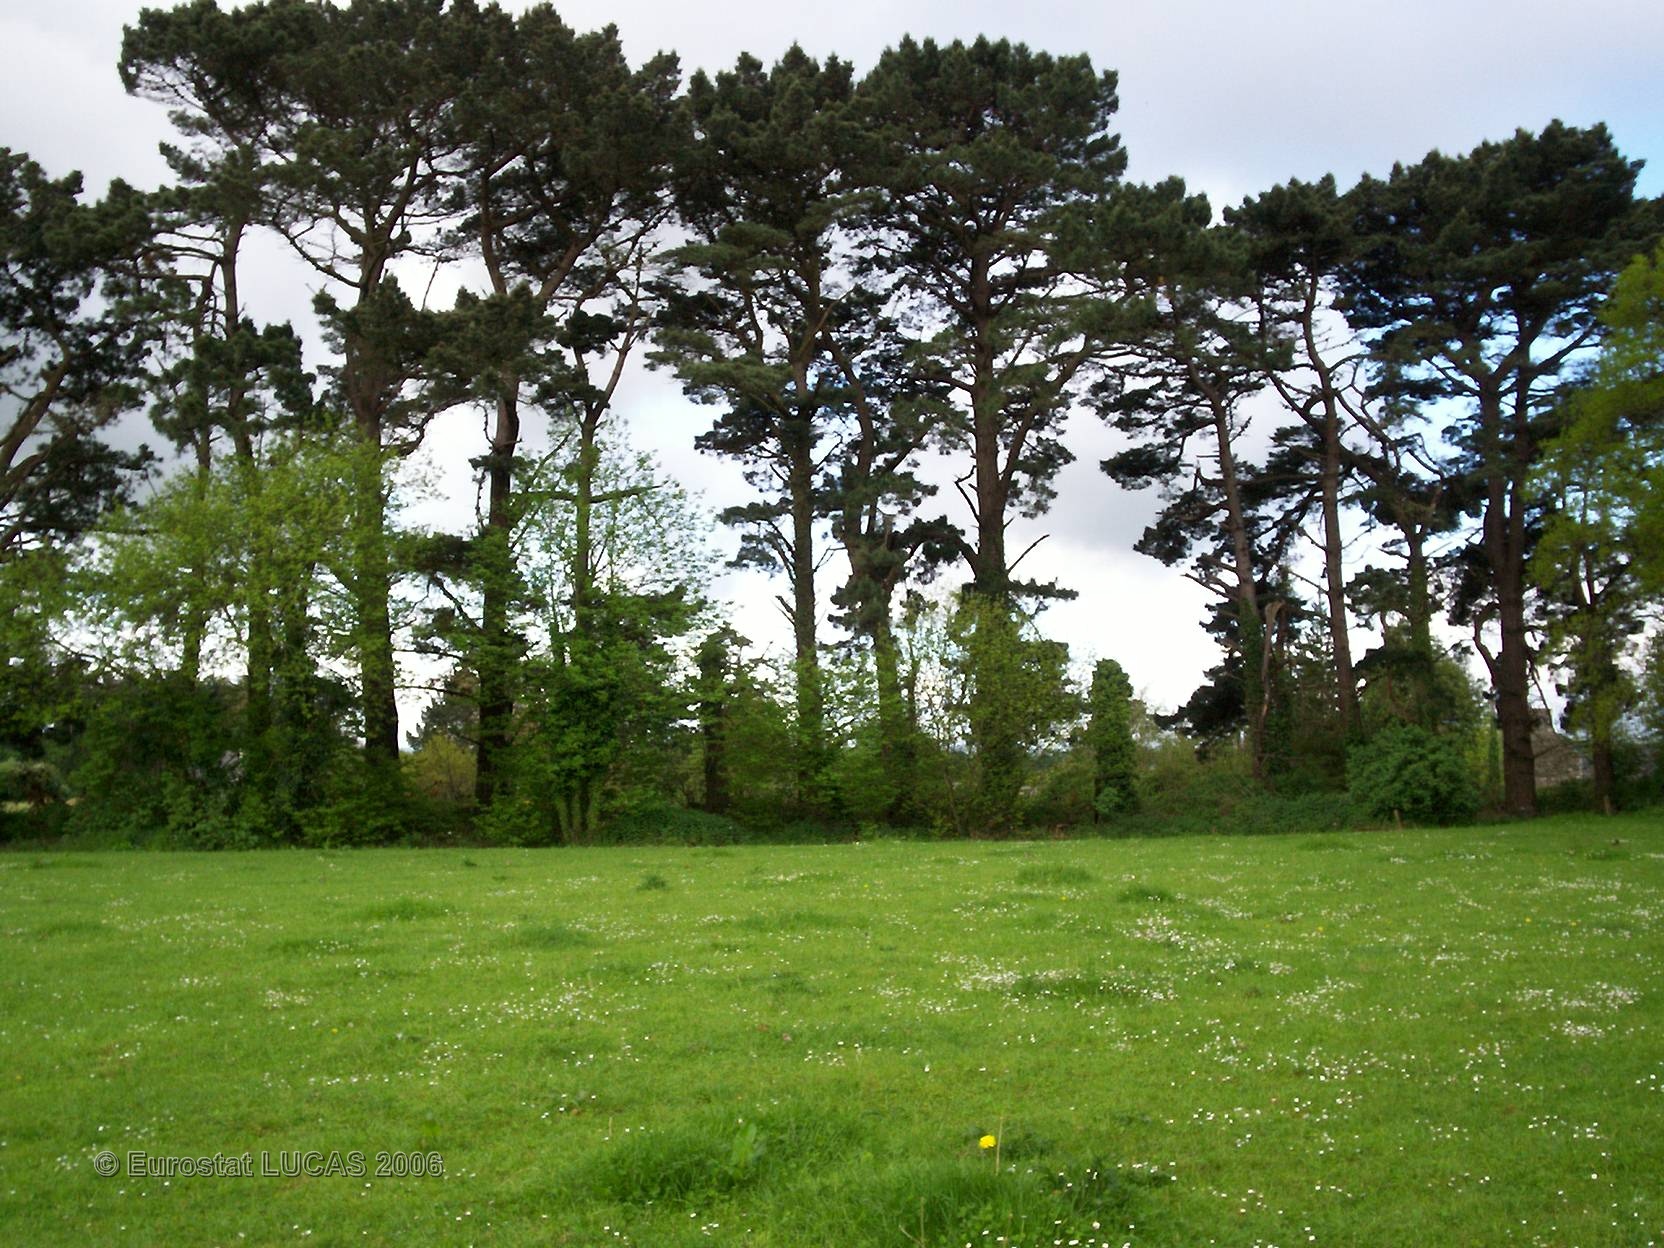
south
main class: Grassland
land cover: Grassland without tree/shrub cover
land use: Agriculture (excluding fallow land and kitchen gardens)
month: May
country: FR
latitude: 48.5749
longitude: -3.7875
